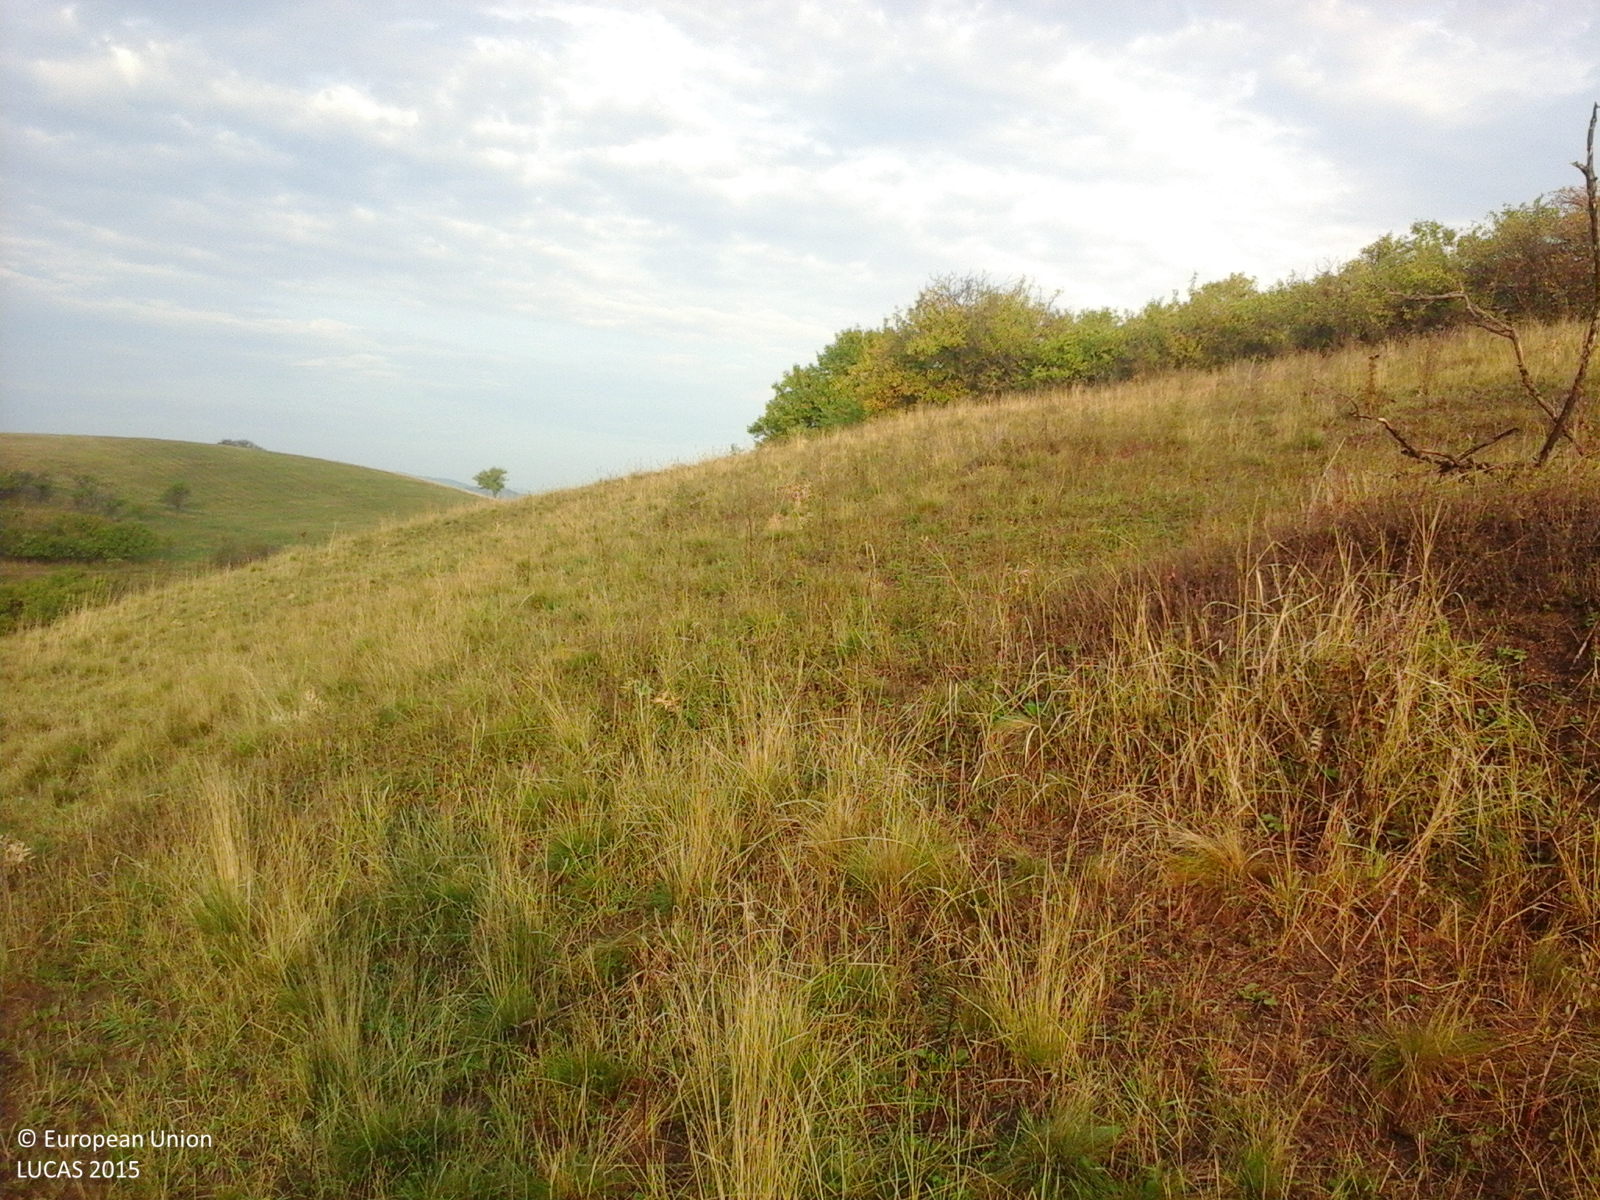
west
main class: Grassland
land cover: Grassland without tree/shrub cover
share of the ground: > 75 %
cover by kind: herbaceous plants 100 %
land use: Agriculture (excluding fallow land and kitchen gardens)
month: September
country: RO
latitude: 45.6576
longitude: 22.8987
